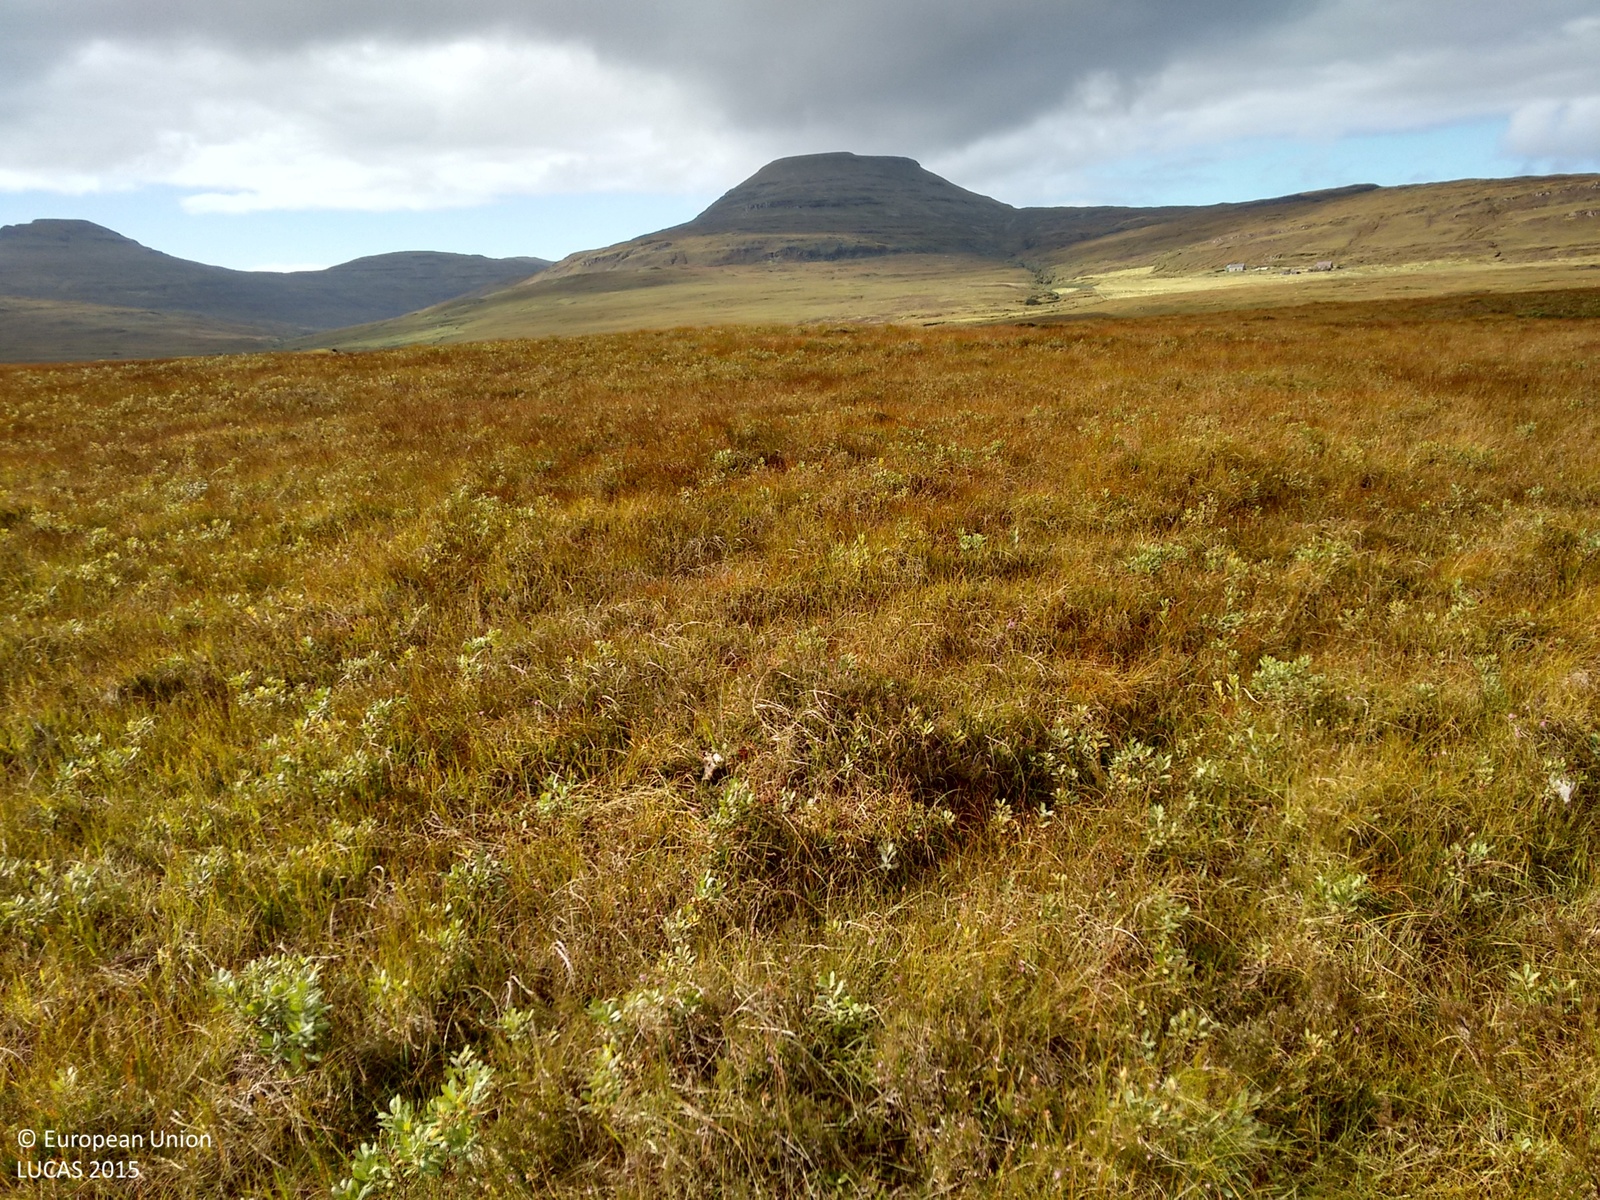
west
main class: Shrubland
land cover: Shrubland without tree cover
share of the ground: > 75 %
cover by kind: shrubs 75 %, herbaceous plants 25 %
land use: Agriculture (excluding fallow land and kitchen gardens)
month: September
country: GB
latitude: 57.4180
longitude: -6.5788
